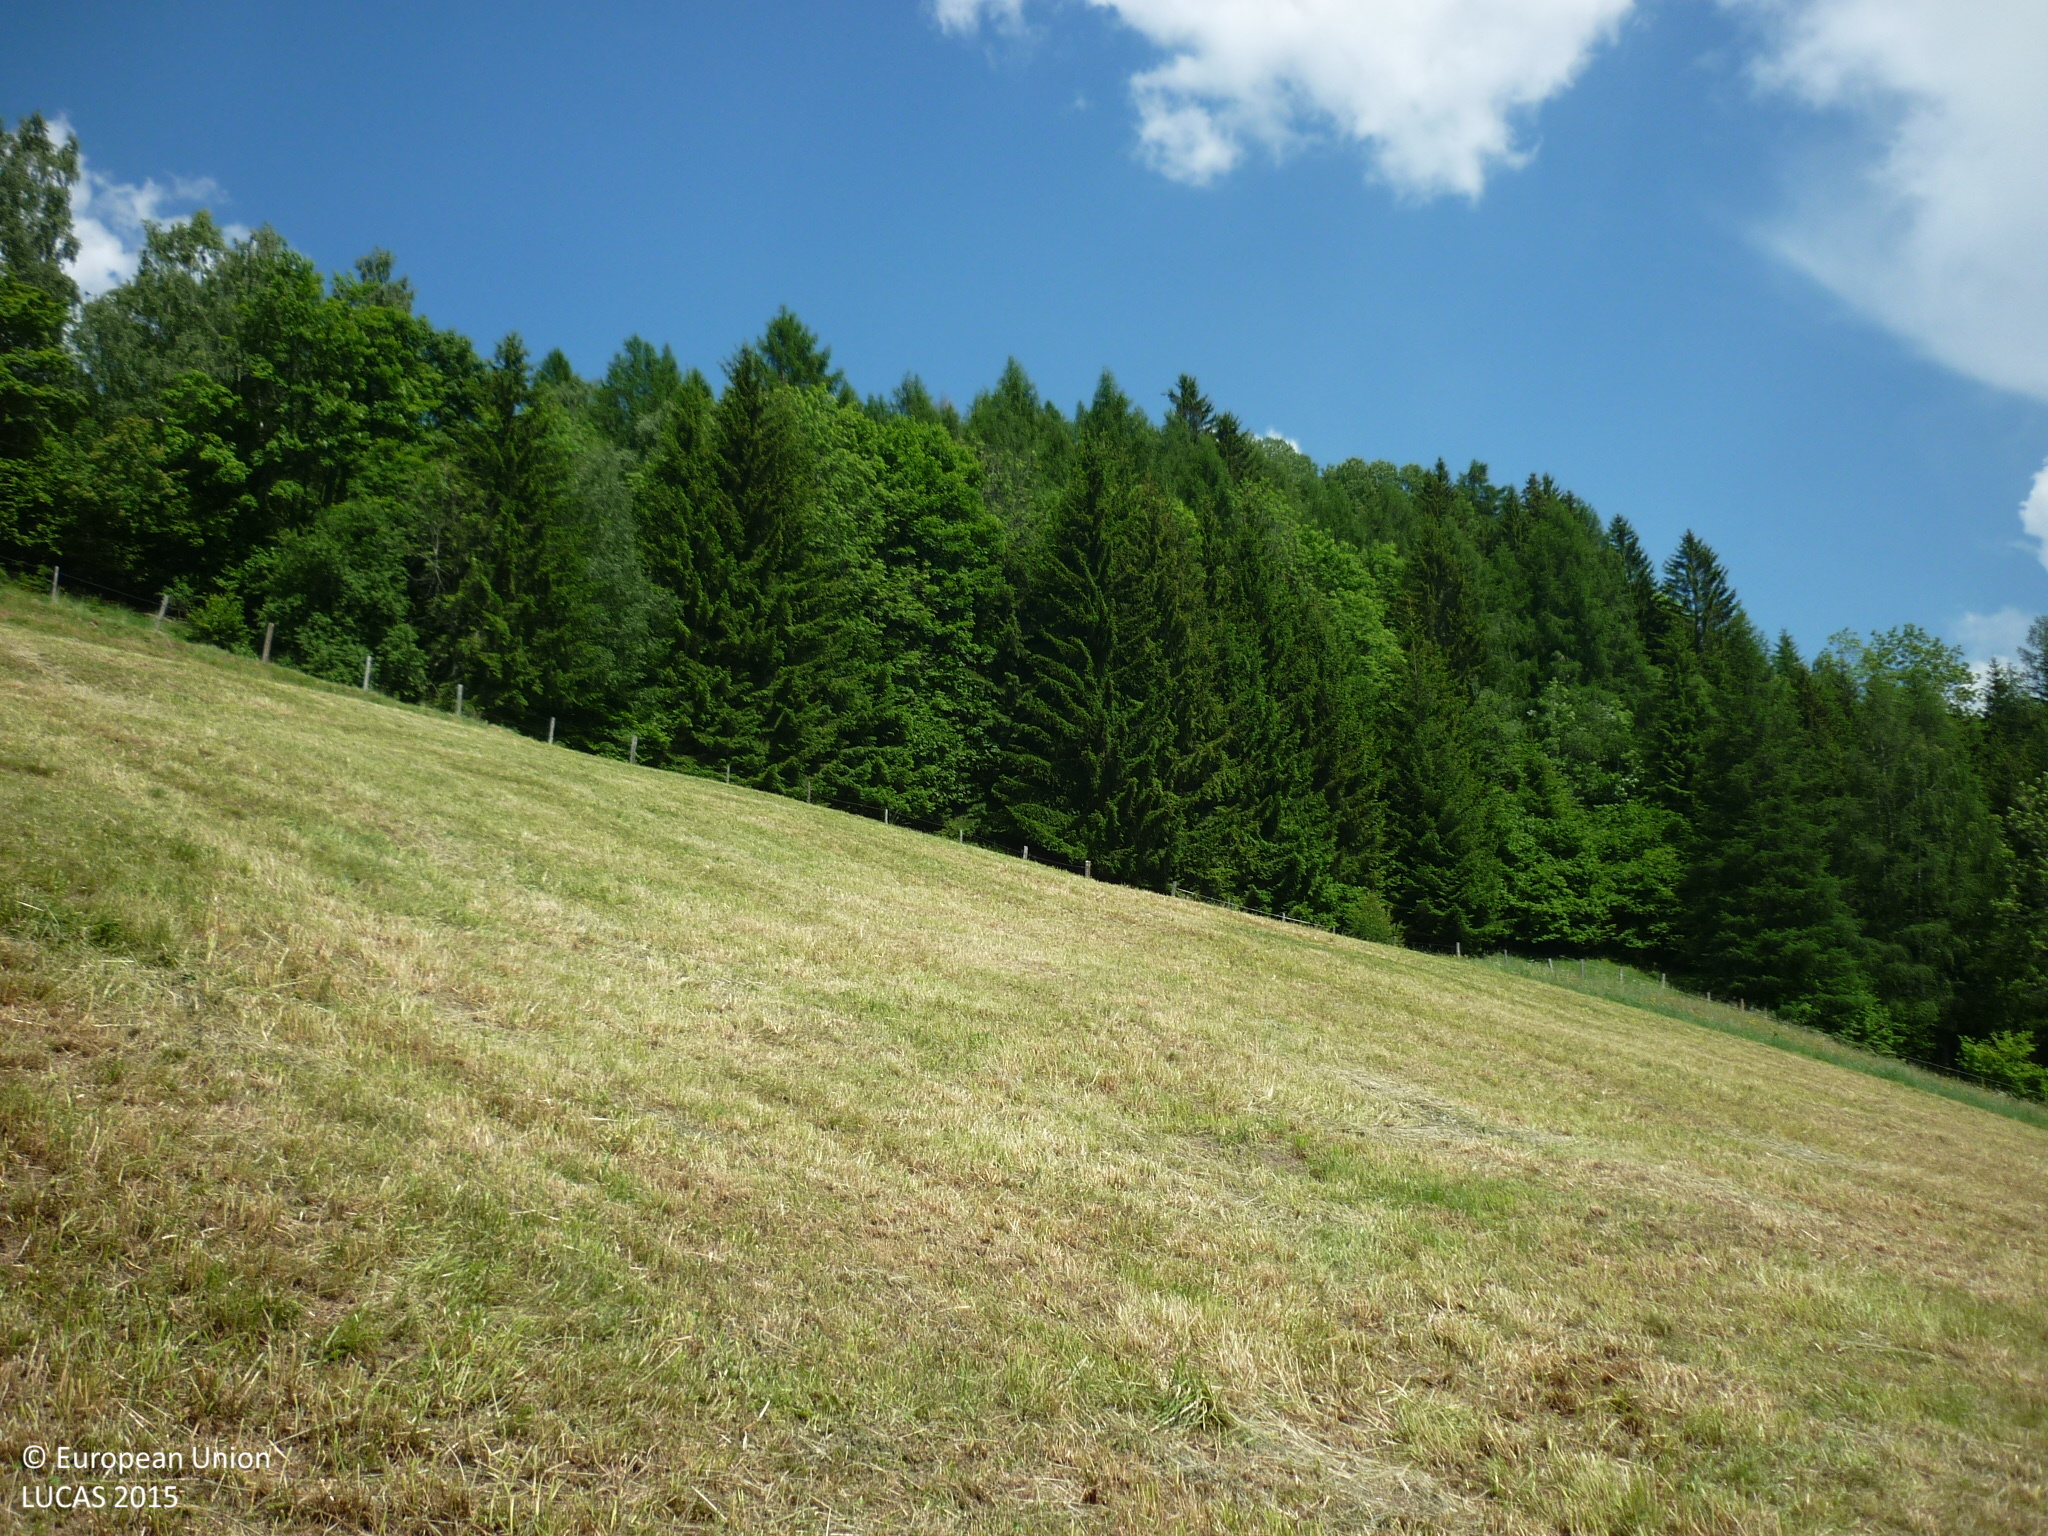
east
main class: Grassland
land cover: Grassland without tree/shrub cover
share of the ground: > 75 %
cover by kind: herbaceous plants 100 %
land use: Agriculture (excluding fallow land and kitchen gardens)
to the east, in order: Grassland without tree/shrub cover; Fences; Paved roads, cycling and walking lanes; Fences; Grassland without tree/shrub cover; Other coniferous woodland; Tracks; Grassland without tree/shrub cover; Other coniferous woodland; Fences; Grass margins; Paved roads, cycling and walking lanes; Grass margins; Fences; Other coniferous woodland; Grassland without tree/shrub cover
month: June
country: AT
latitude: 47.1731
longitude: 14.1279
